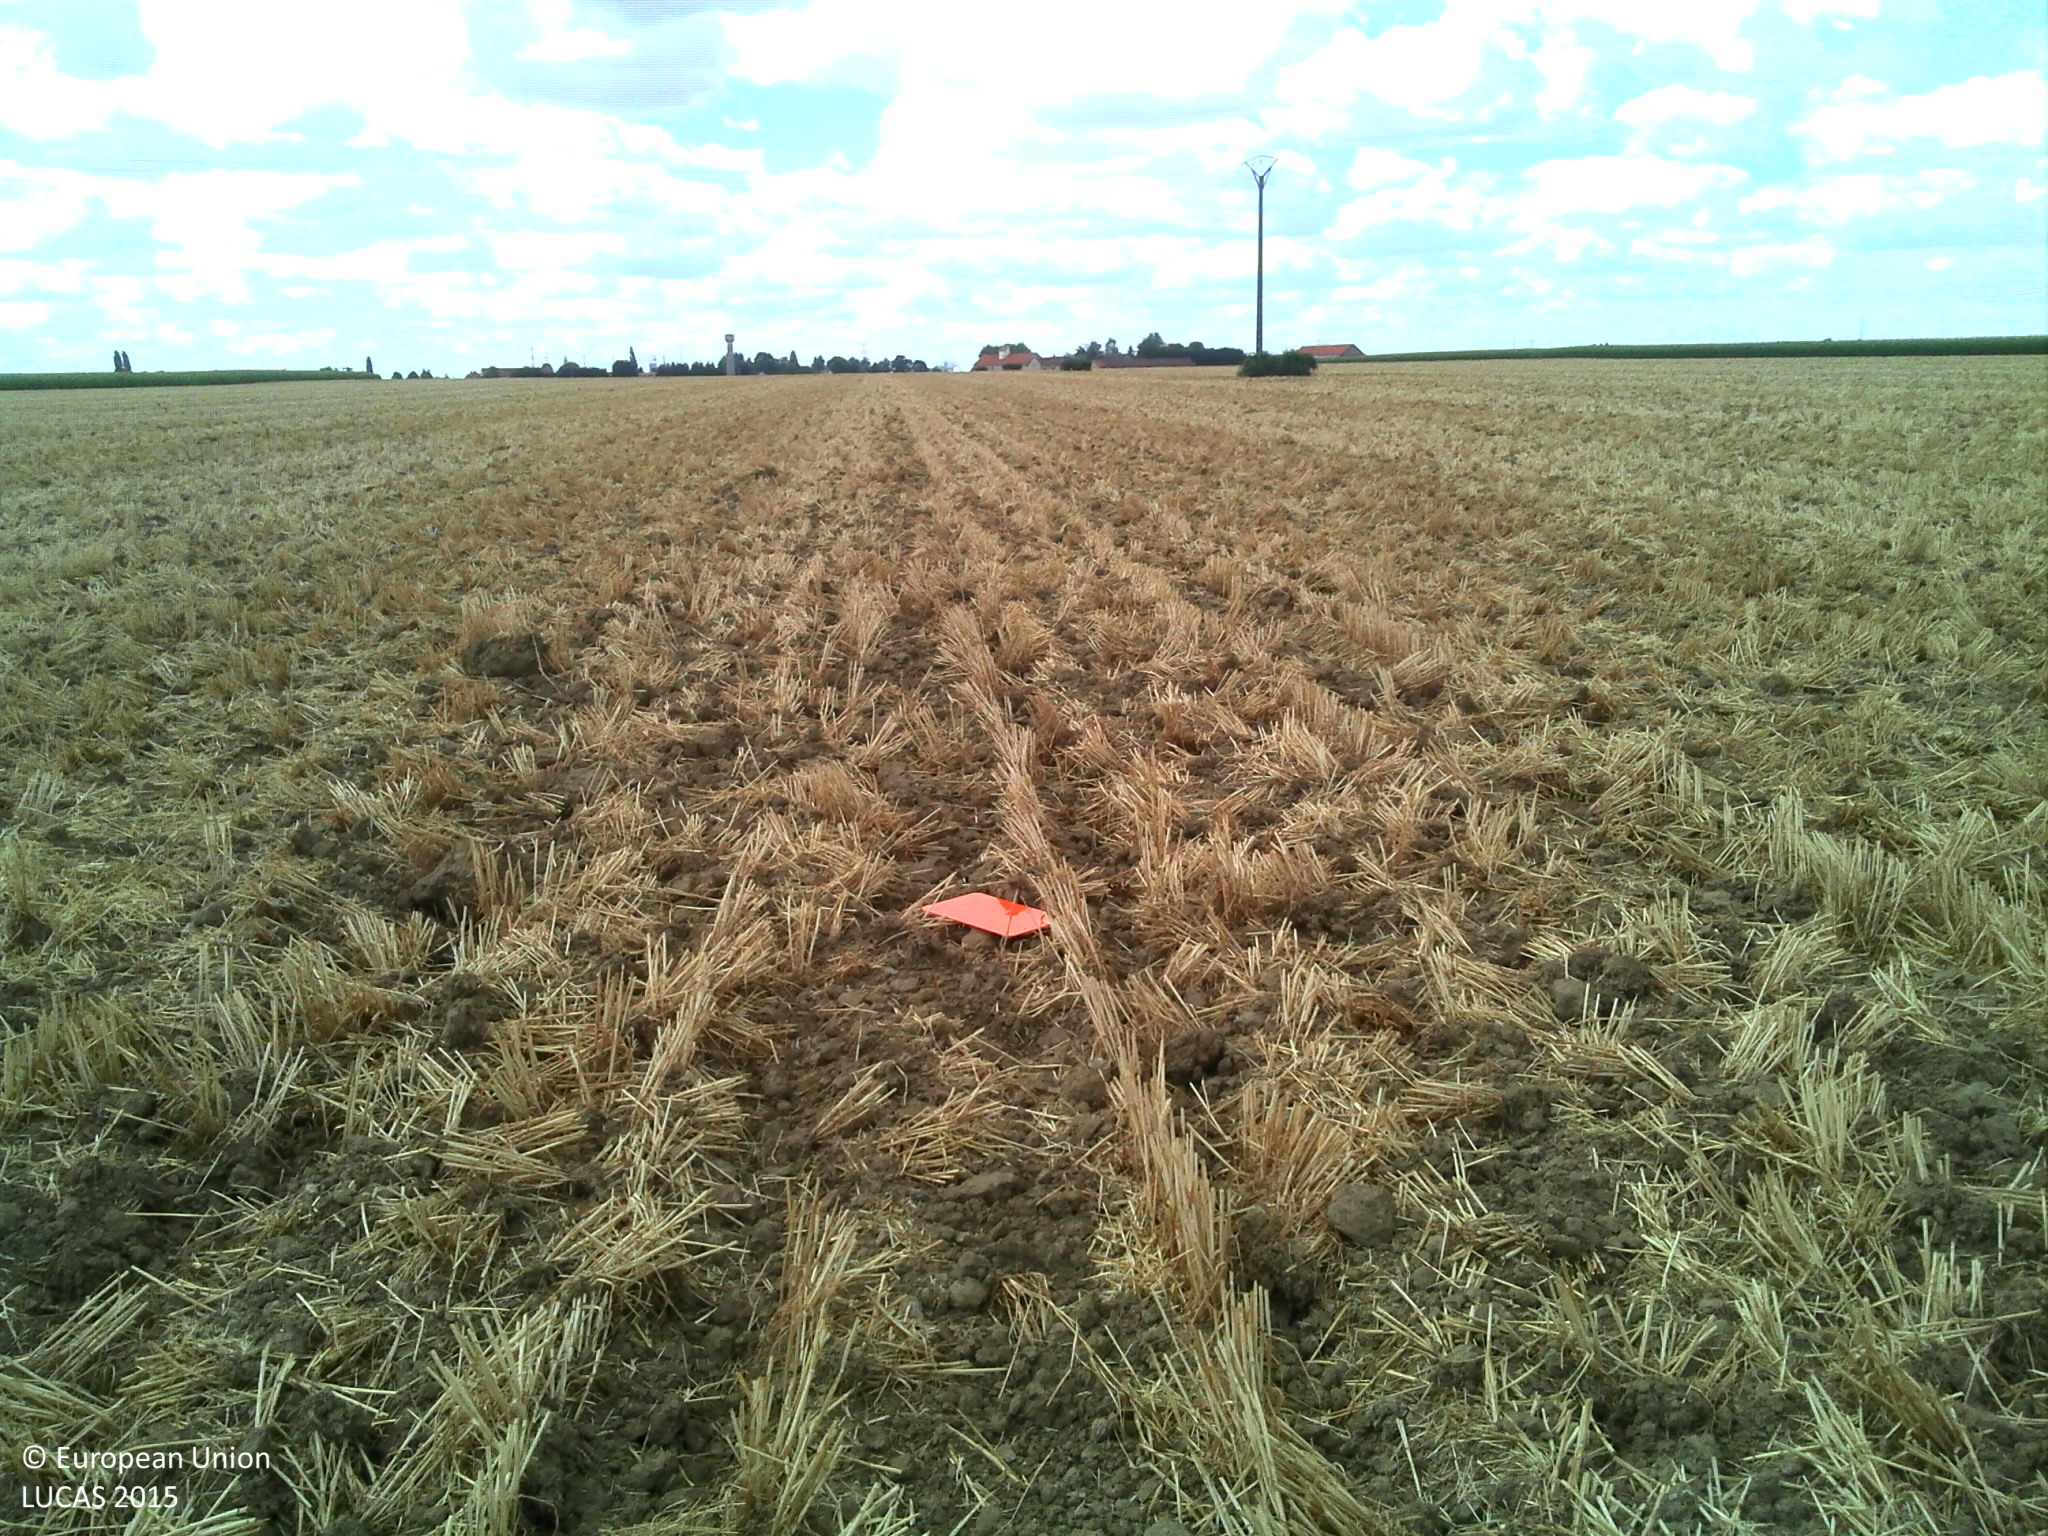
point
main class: Cropland
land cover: Common wheat
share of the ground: > 75 %
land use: Agriculture (excluding fallow land and kitchen gardens)
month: July
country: FR
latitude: 48.6315
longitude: 2.9764
